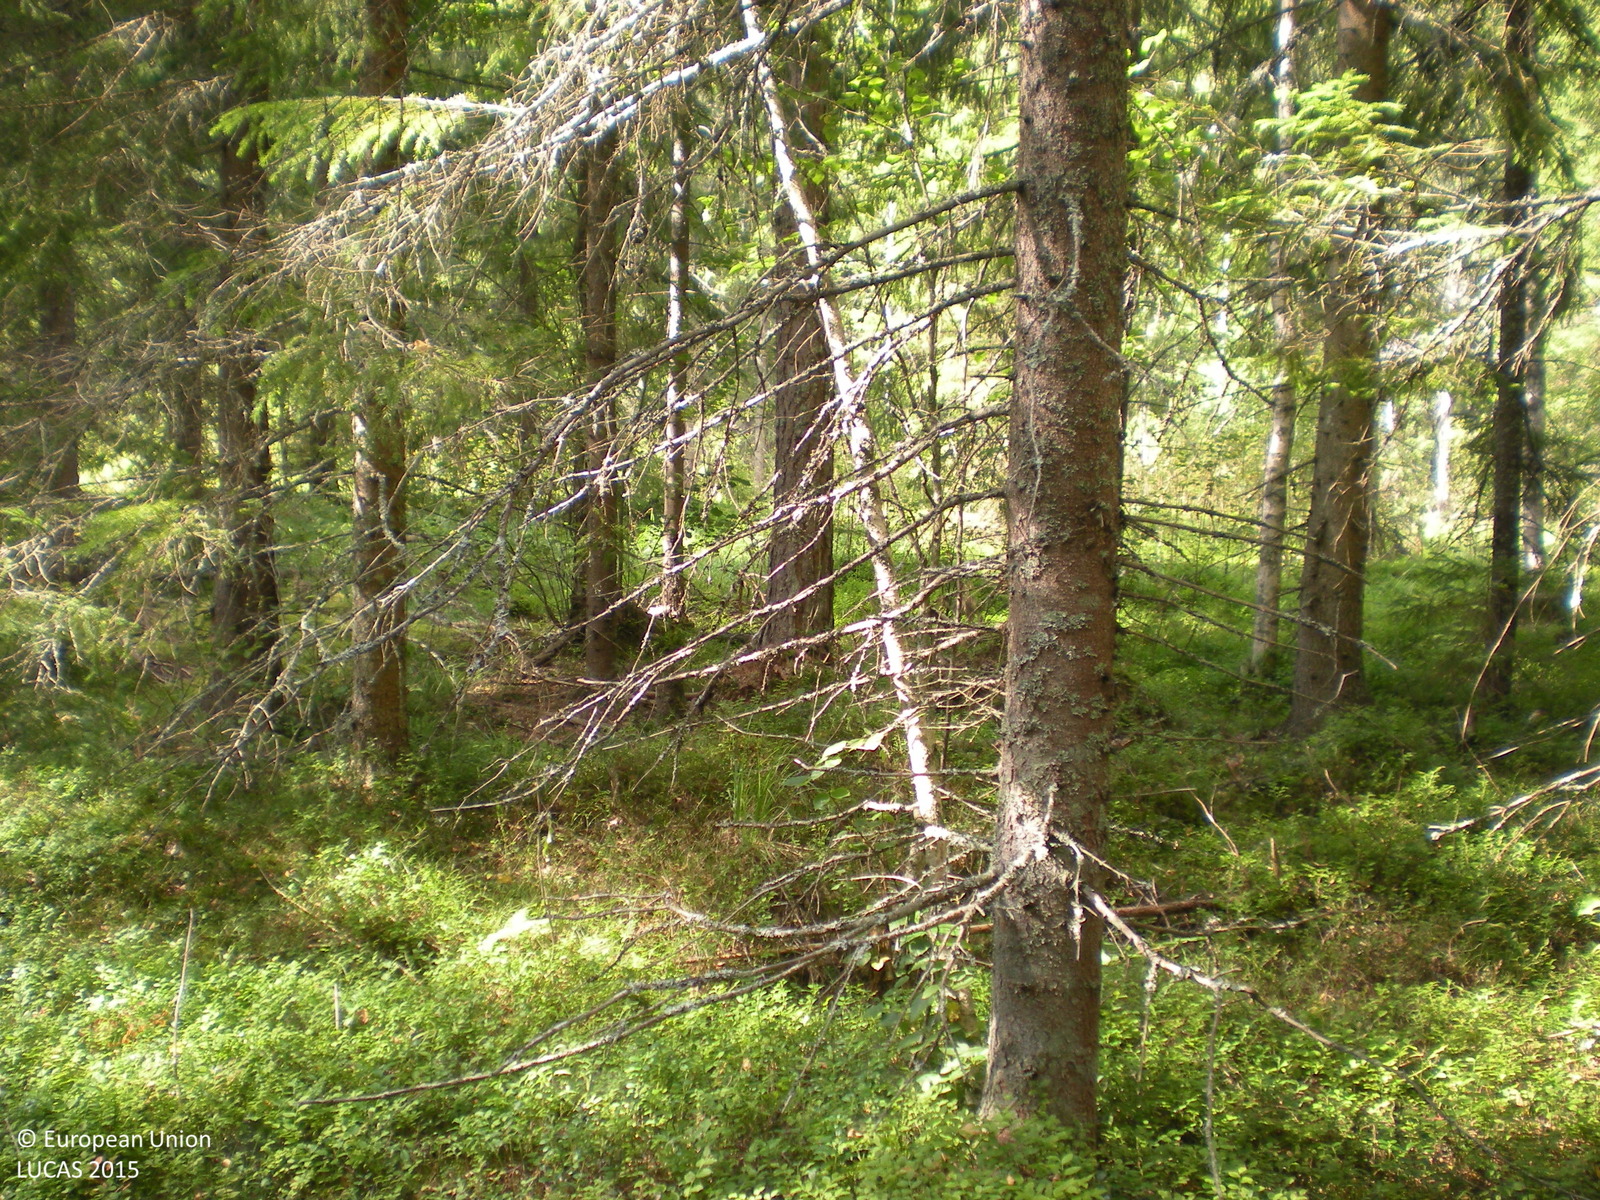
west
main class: Woodland
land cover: Spruce dominated mixed woodland
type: boreal forest
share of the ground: 50 - 75 %
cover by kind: coniferous forest trees 50 %, broadleaved forest trees 20 %, shrubs 20 %, herbaceous plants 5 %, lichens and mosses 5 %
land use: Forestry
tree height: > 5 m
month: August
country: SE
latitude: 60.4646
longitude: 17.2464
